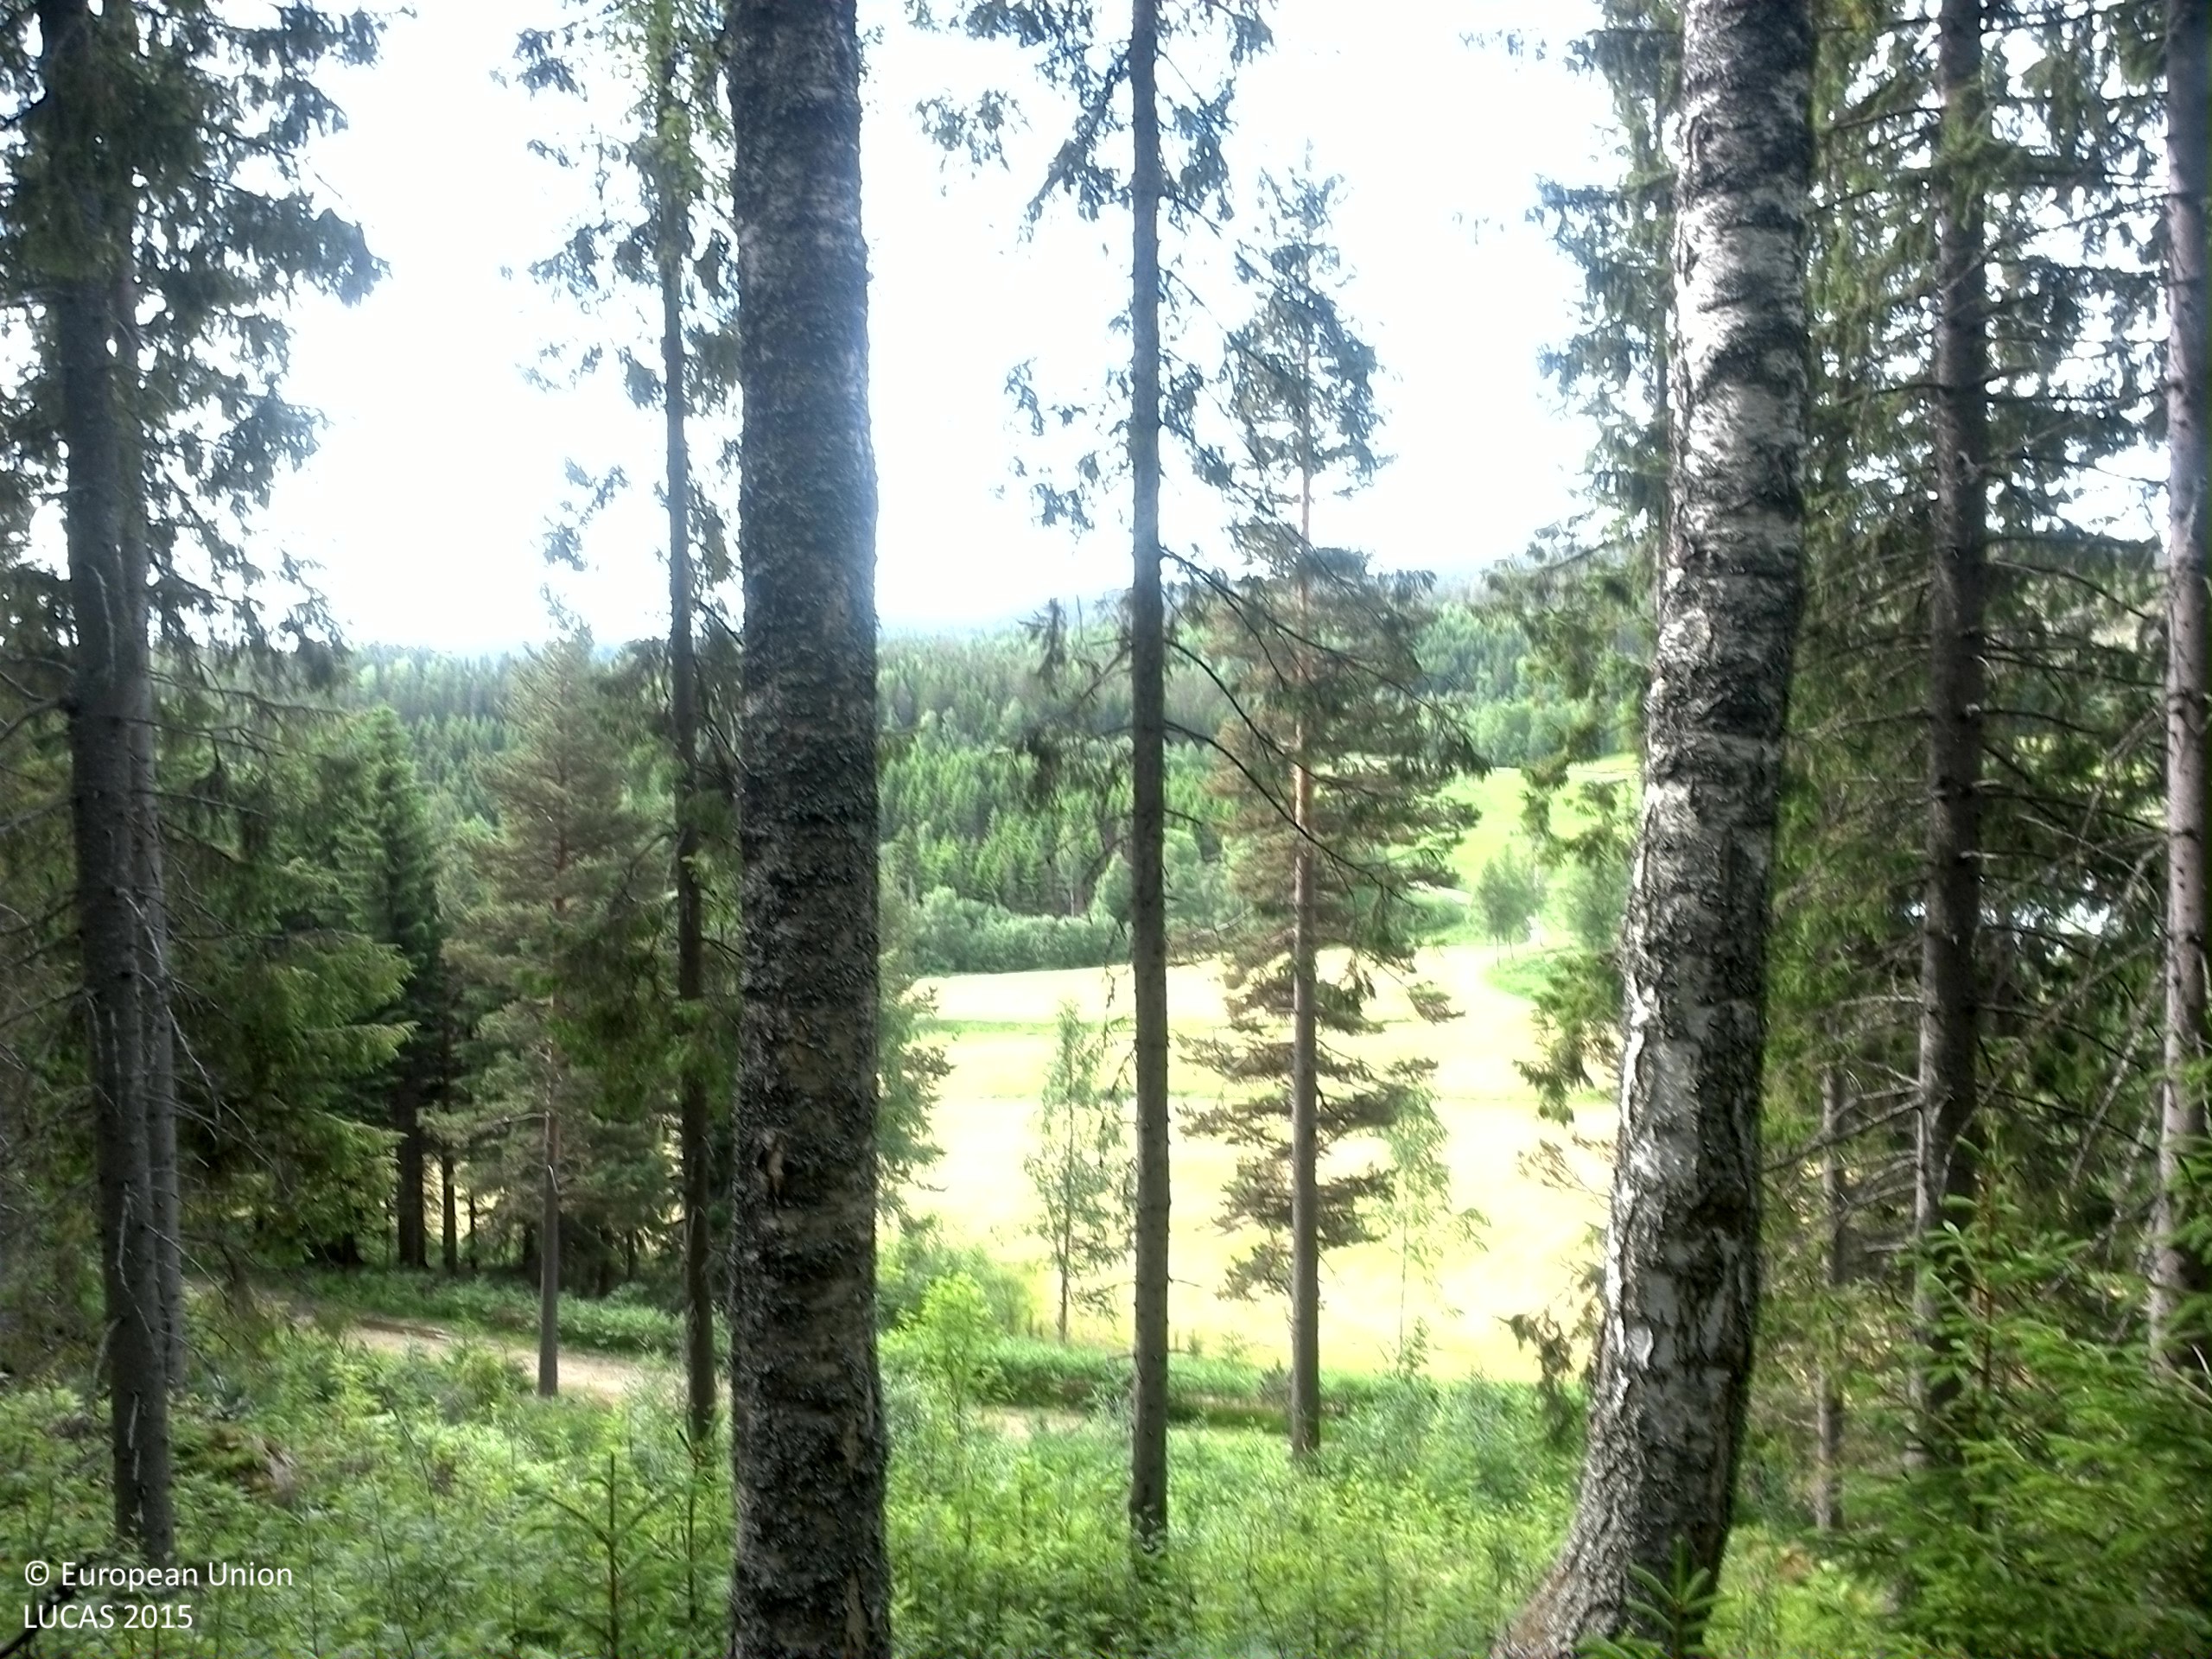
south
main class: Woodland
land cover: Spruce dominated mixed woodland
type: boreal forest
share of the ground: 50 - 75 %
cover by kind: shrubs 45 %, coniferous forest trees 40 %, broadleaved forest trees 15 %
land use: Forestry
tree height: > 5 m
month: June
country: SE
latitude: 62.8445
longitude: 17.8148
